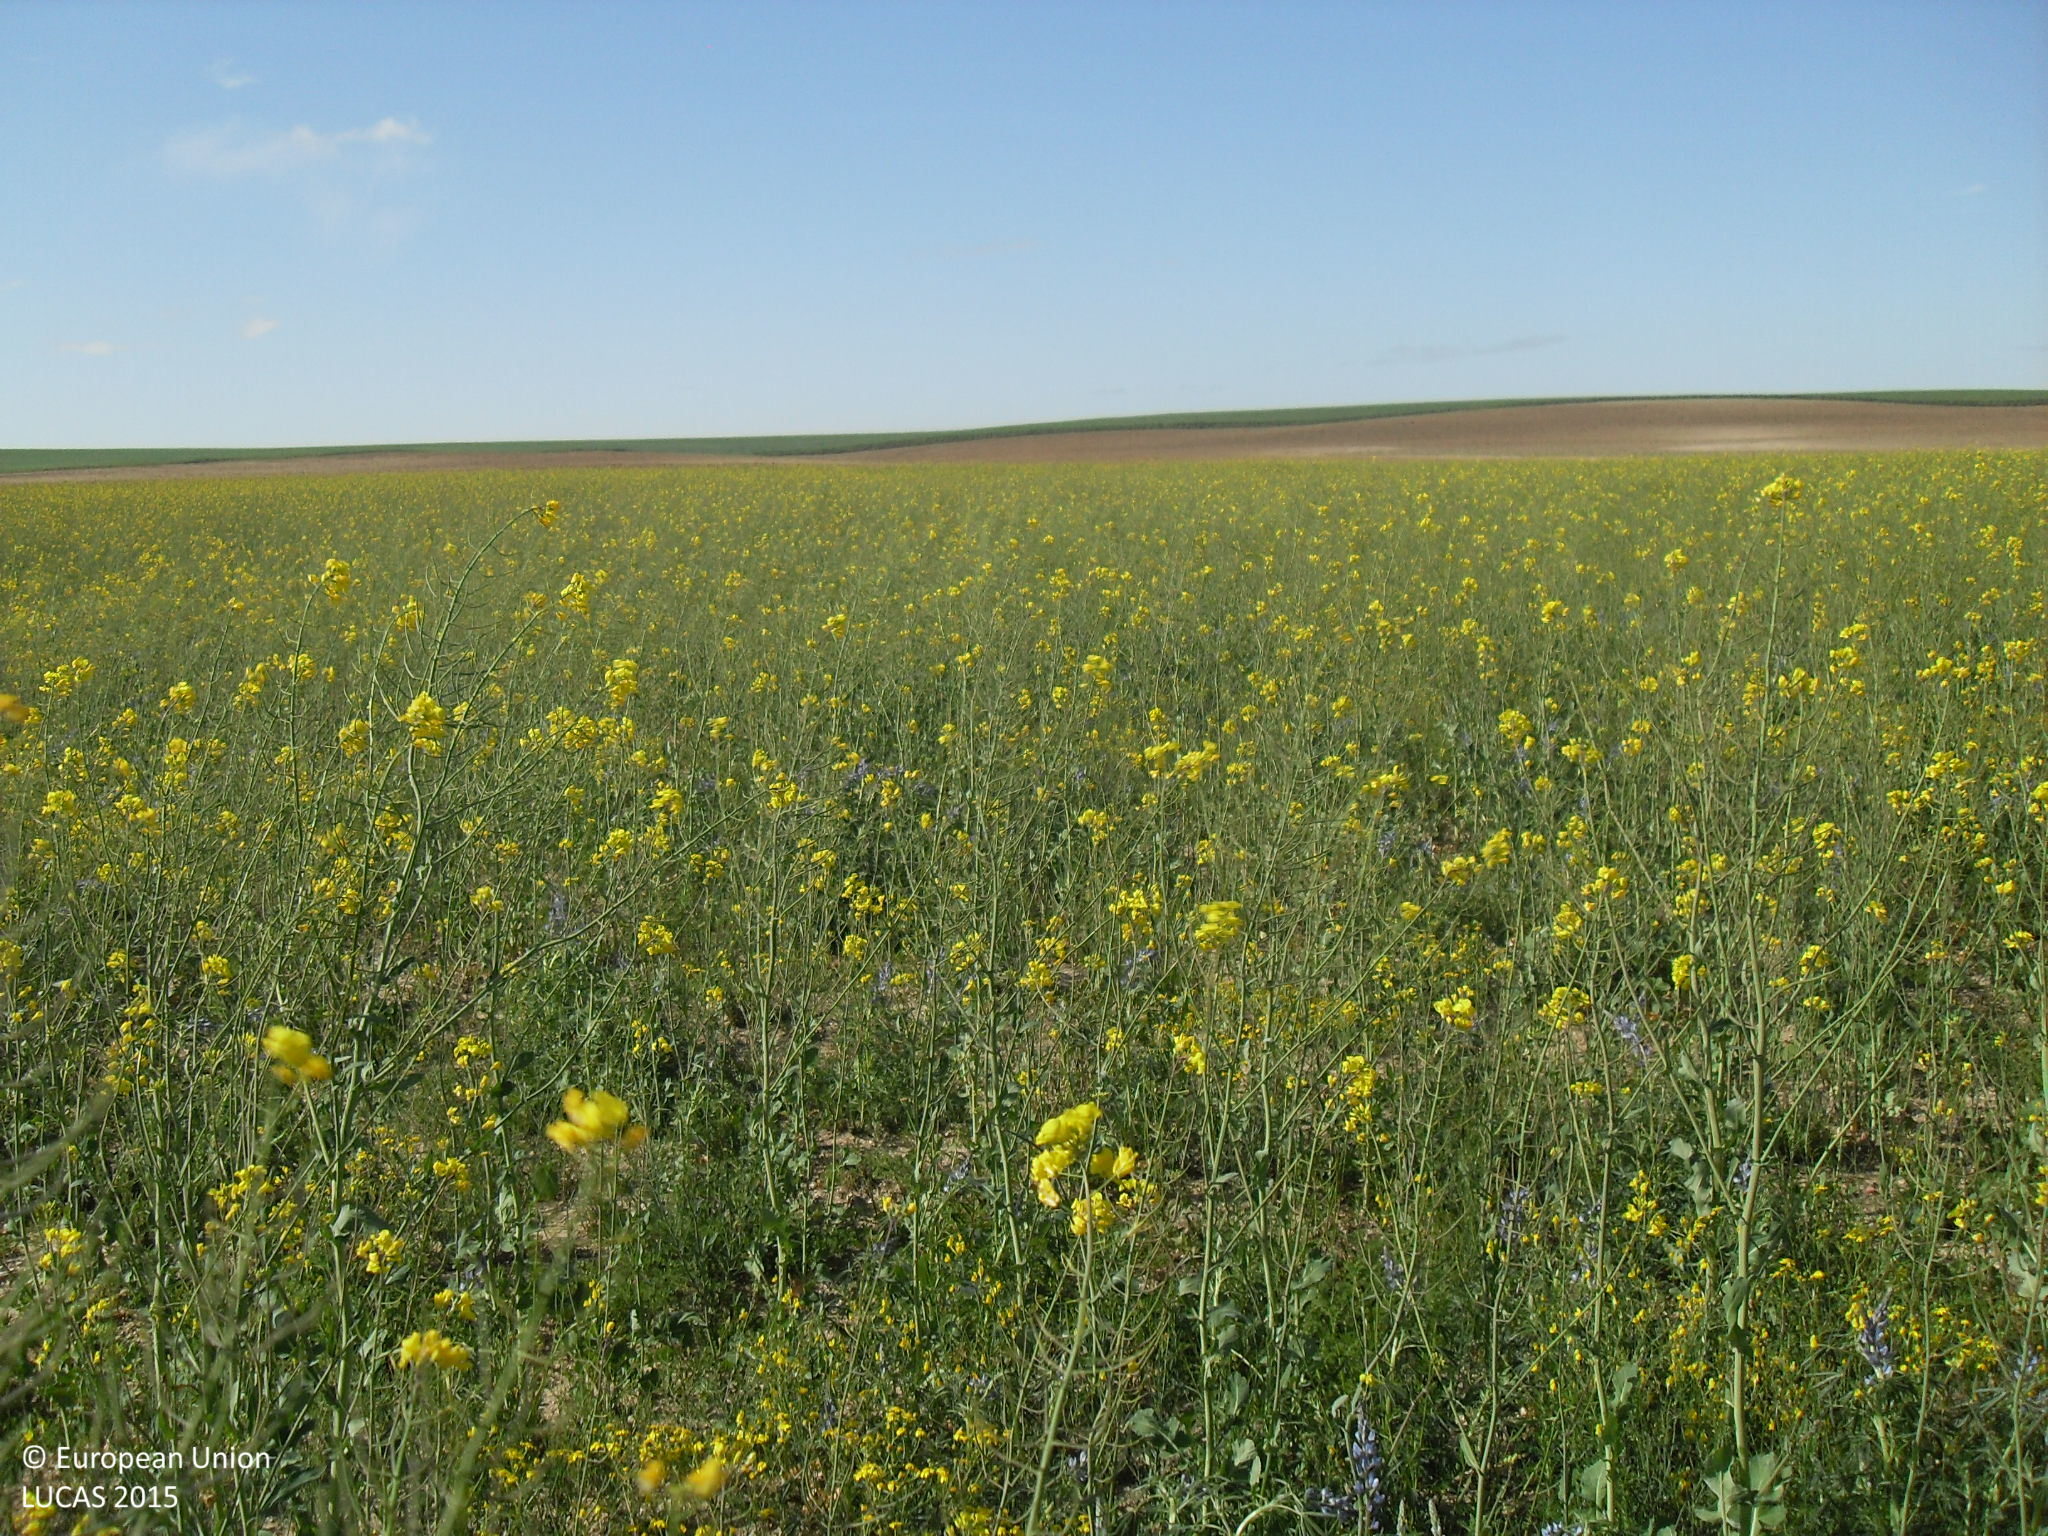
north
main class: Cropland
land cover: Rape and turnip rape
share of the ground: > 75 %
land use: Agriculture (excluding fallow land and kitchen gardens)
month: May
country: ES
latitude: 40.9355
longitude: -5.2839
